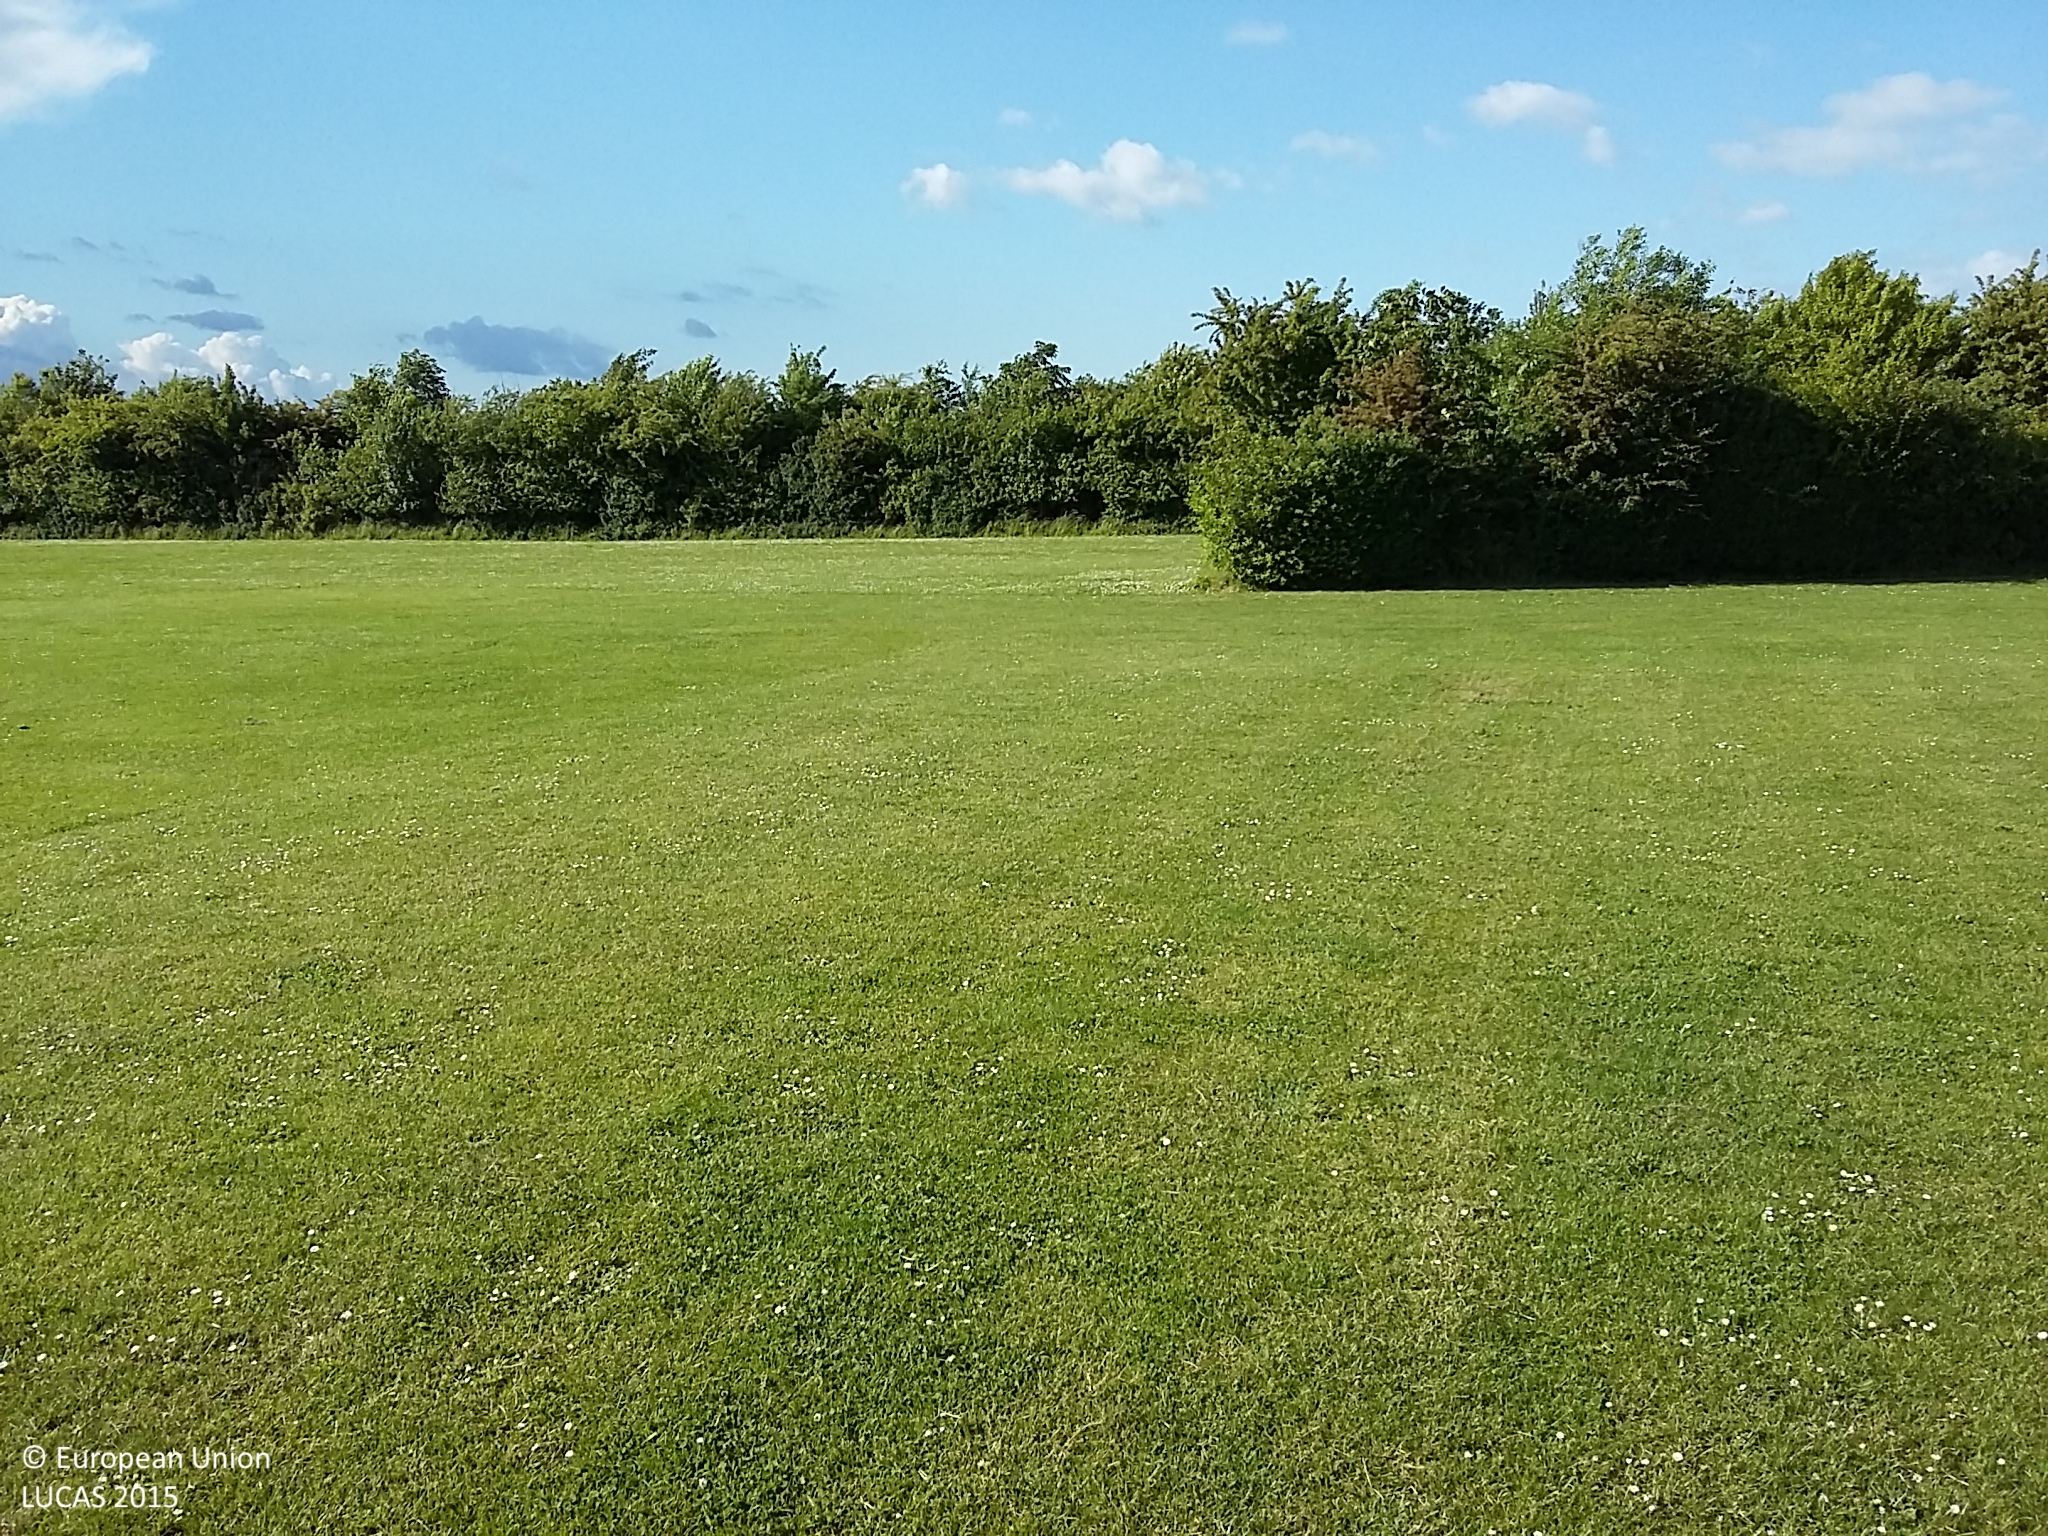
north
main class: Grassland
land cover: Grassland without tree/shrub cover
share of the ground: > 75 %
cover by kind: herbaceous plants 100 %
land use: Sport
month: June
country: DK
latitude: 54.7627
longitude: 11.1337
